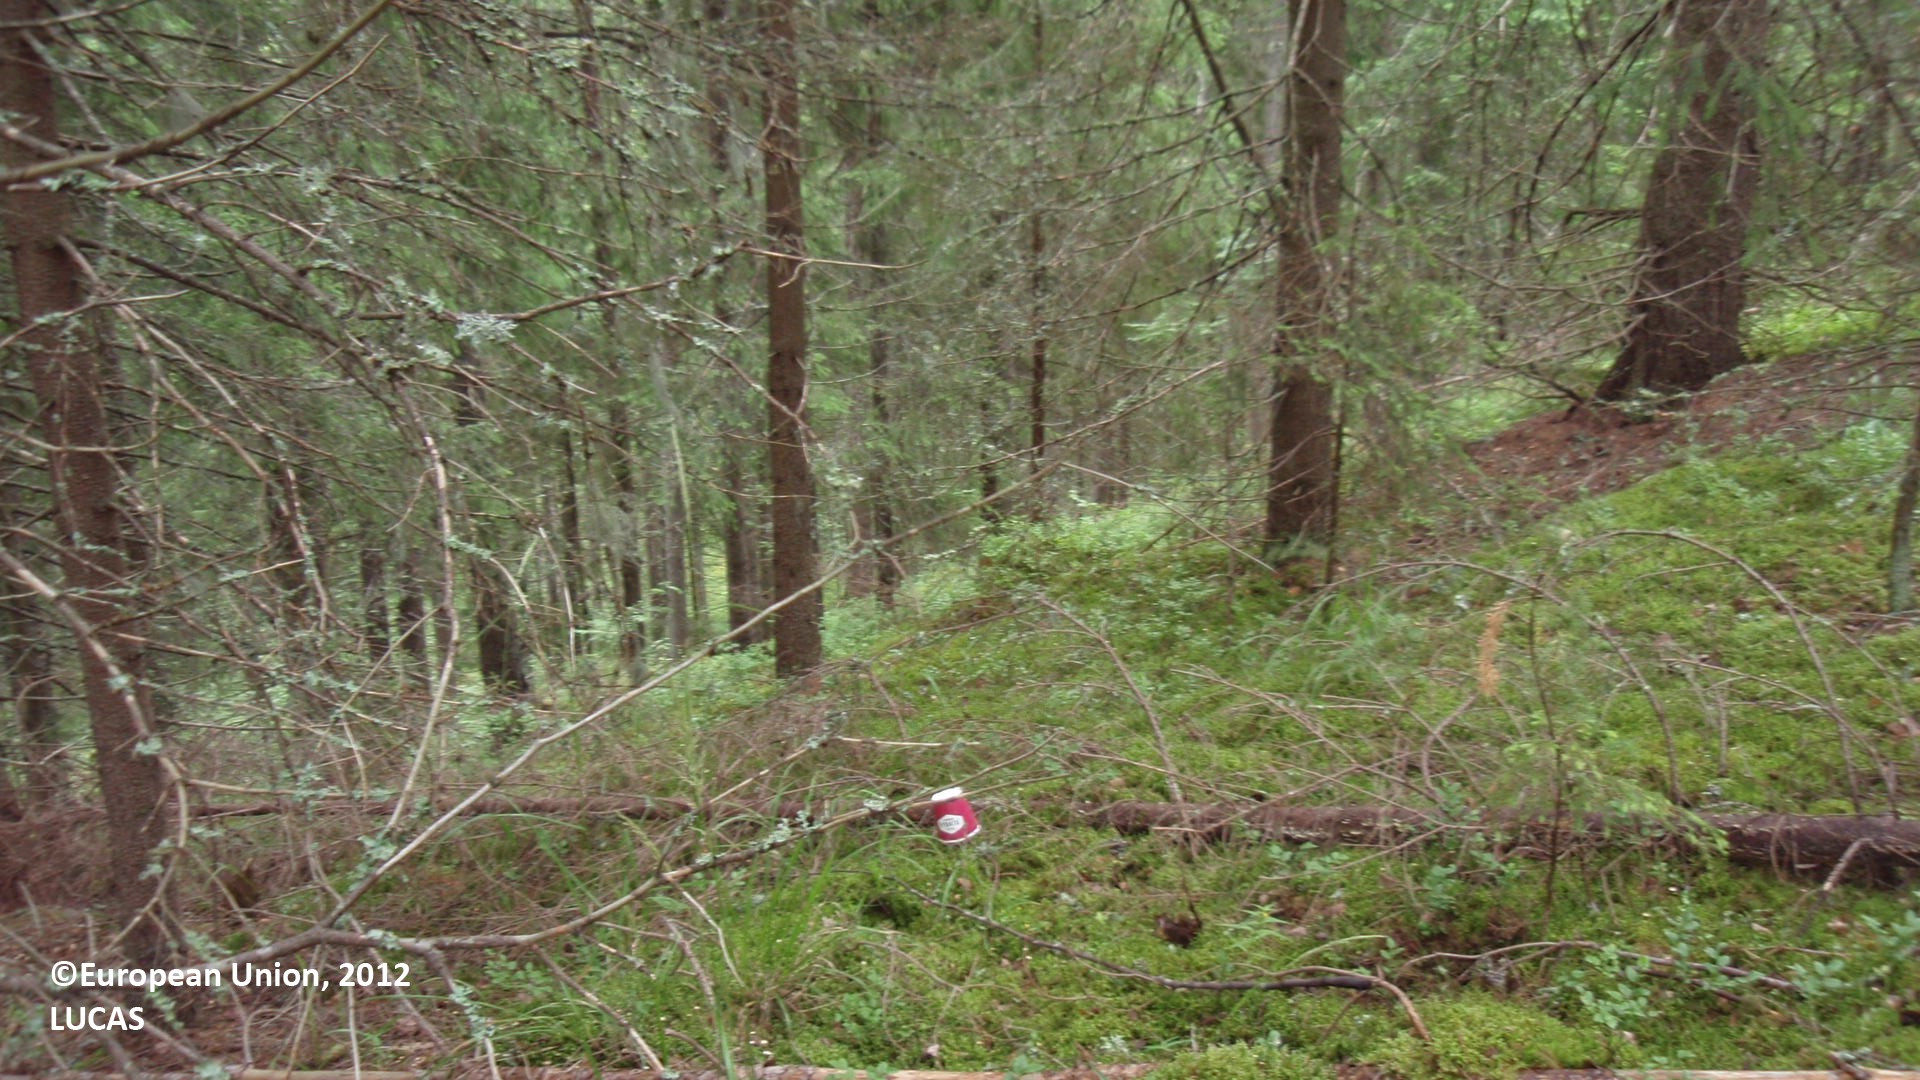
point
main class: Woodland
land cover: Spruce dominated coniferous woodland
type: boreal forest
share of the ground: 50 - 75 %
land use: Forestry
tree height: > 5 m
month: July
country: FI
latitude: 61.1222
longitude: 28.5764
